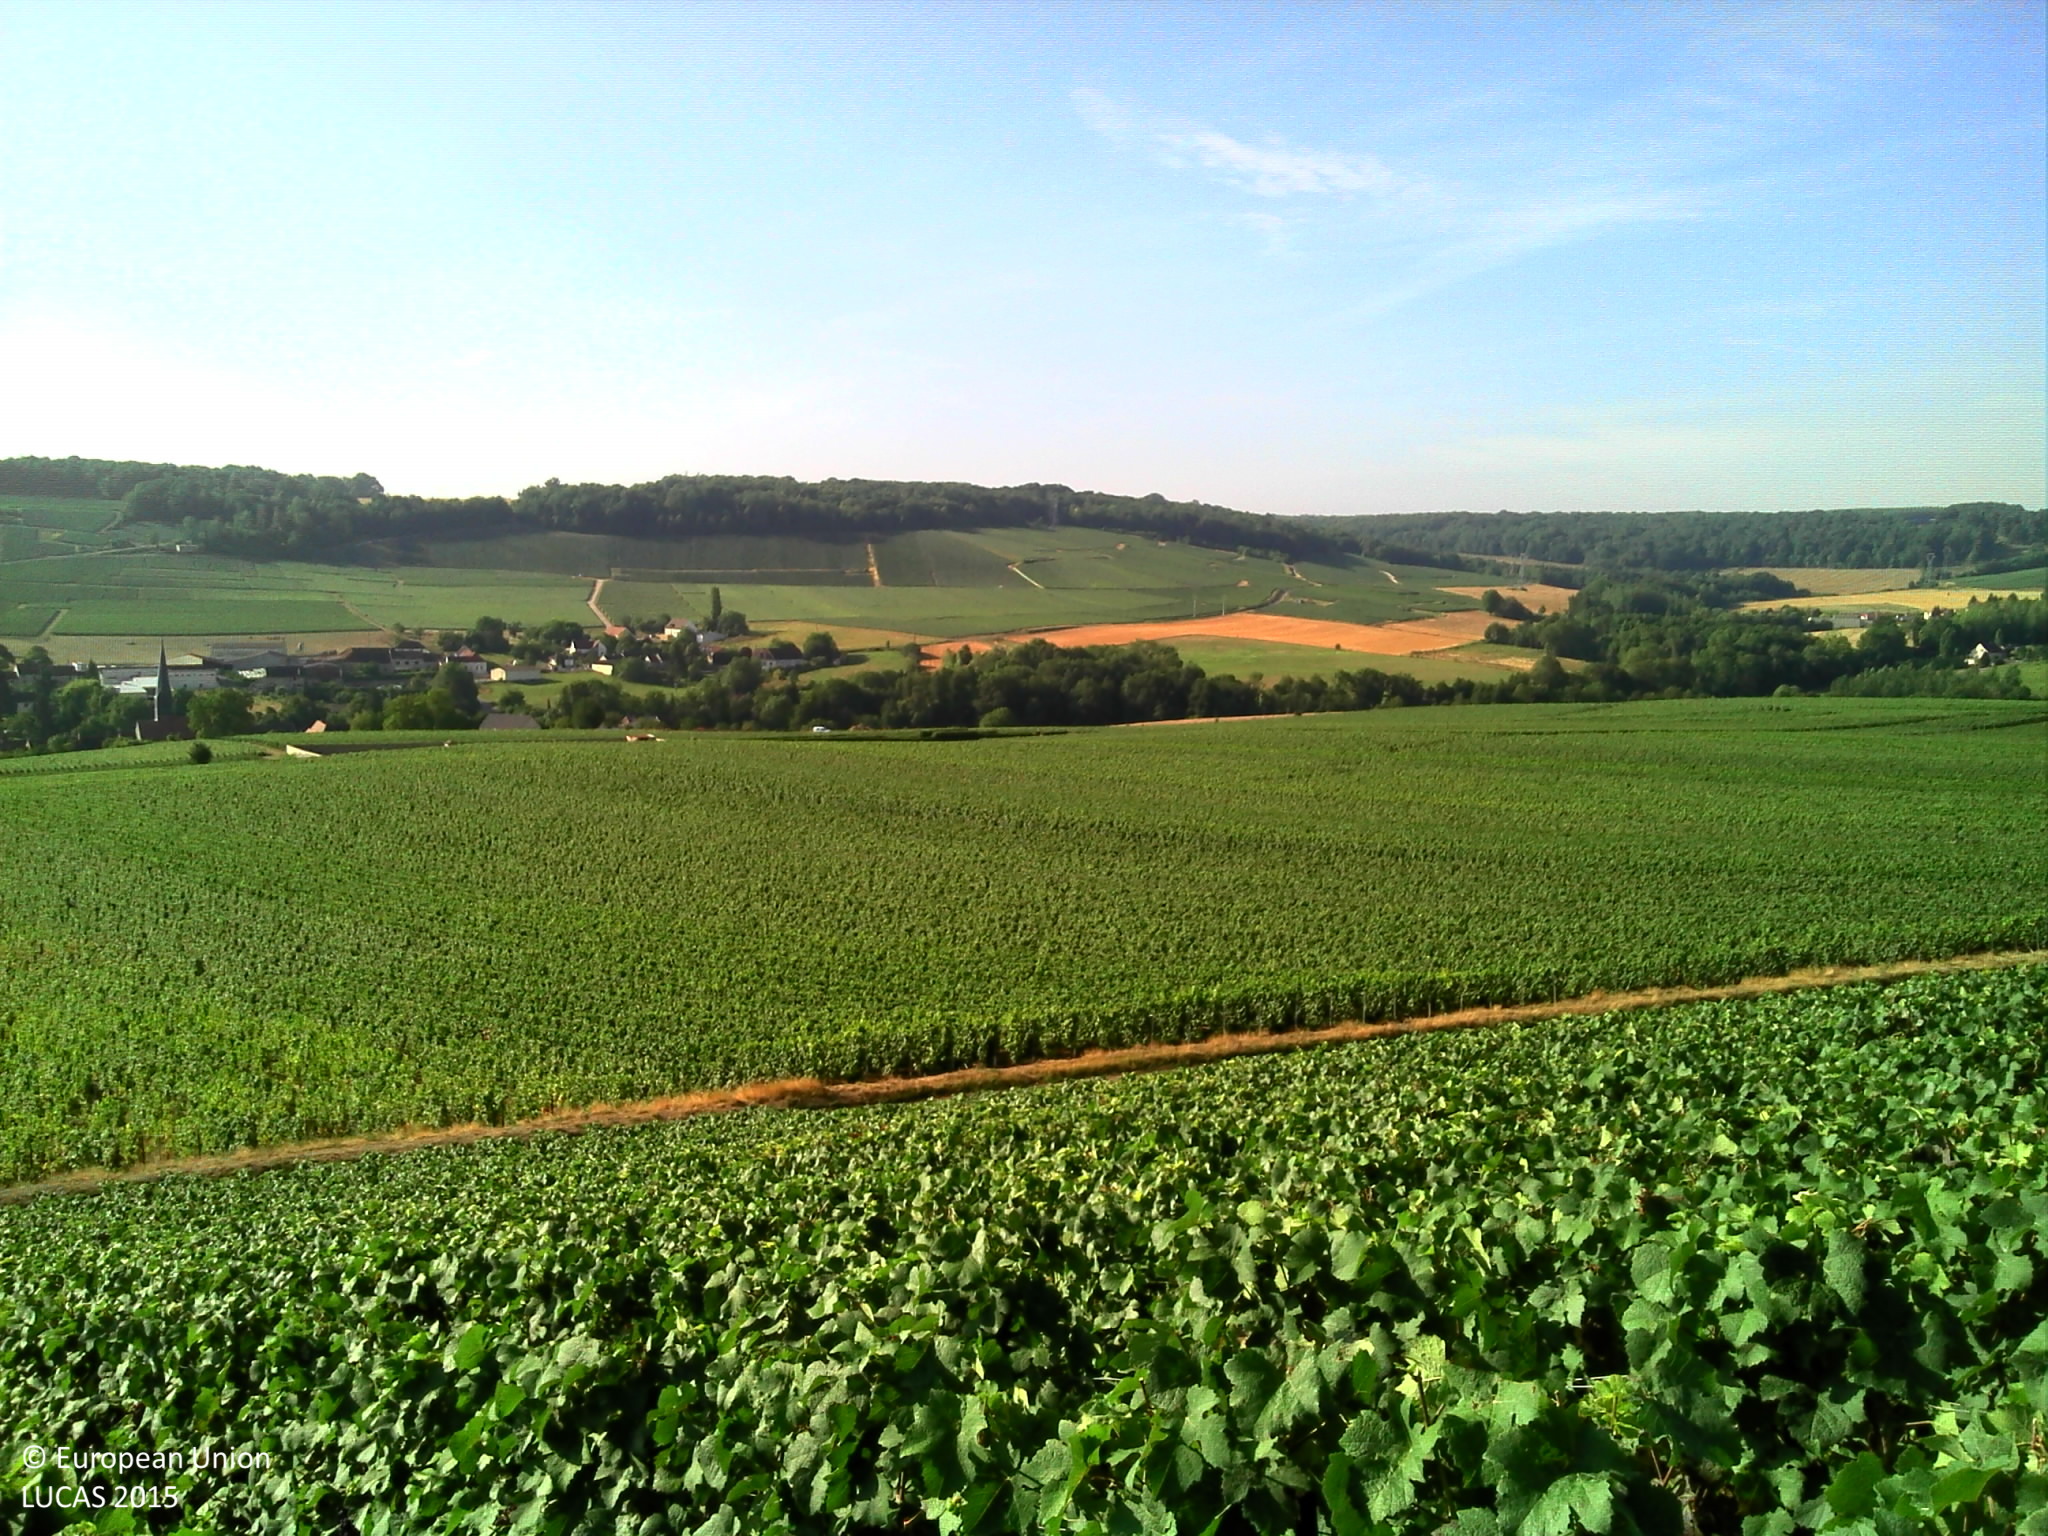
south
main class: Cropland
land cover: Vineyards
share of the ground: > 75 %
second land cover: Other bare soil
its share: > 75 %
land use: Agriculture (excluding fallow land and kitchen gardens)
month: August
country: FR
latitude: 49.0562
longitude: 3.7404
